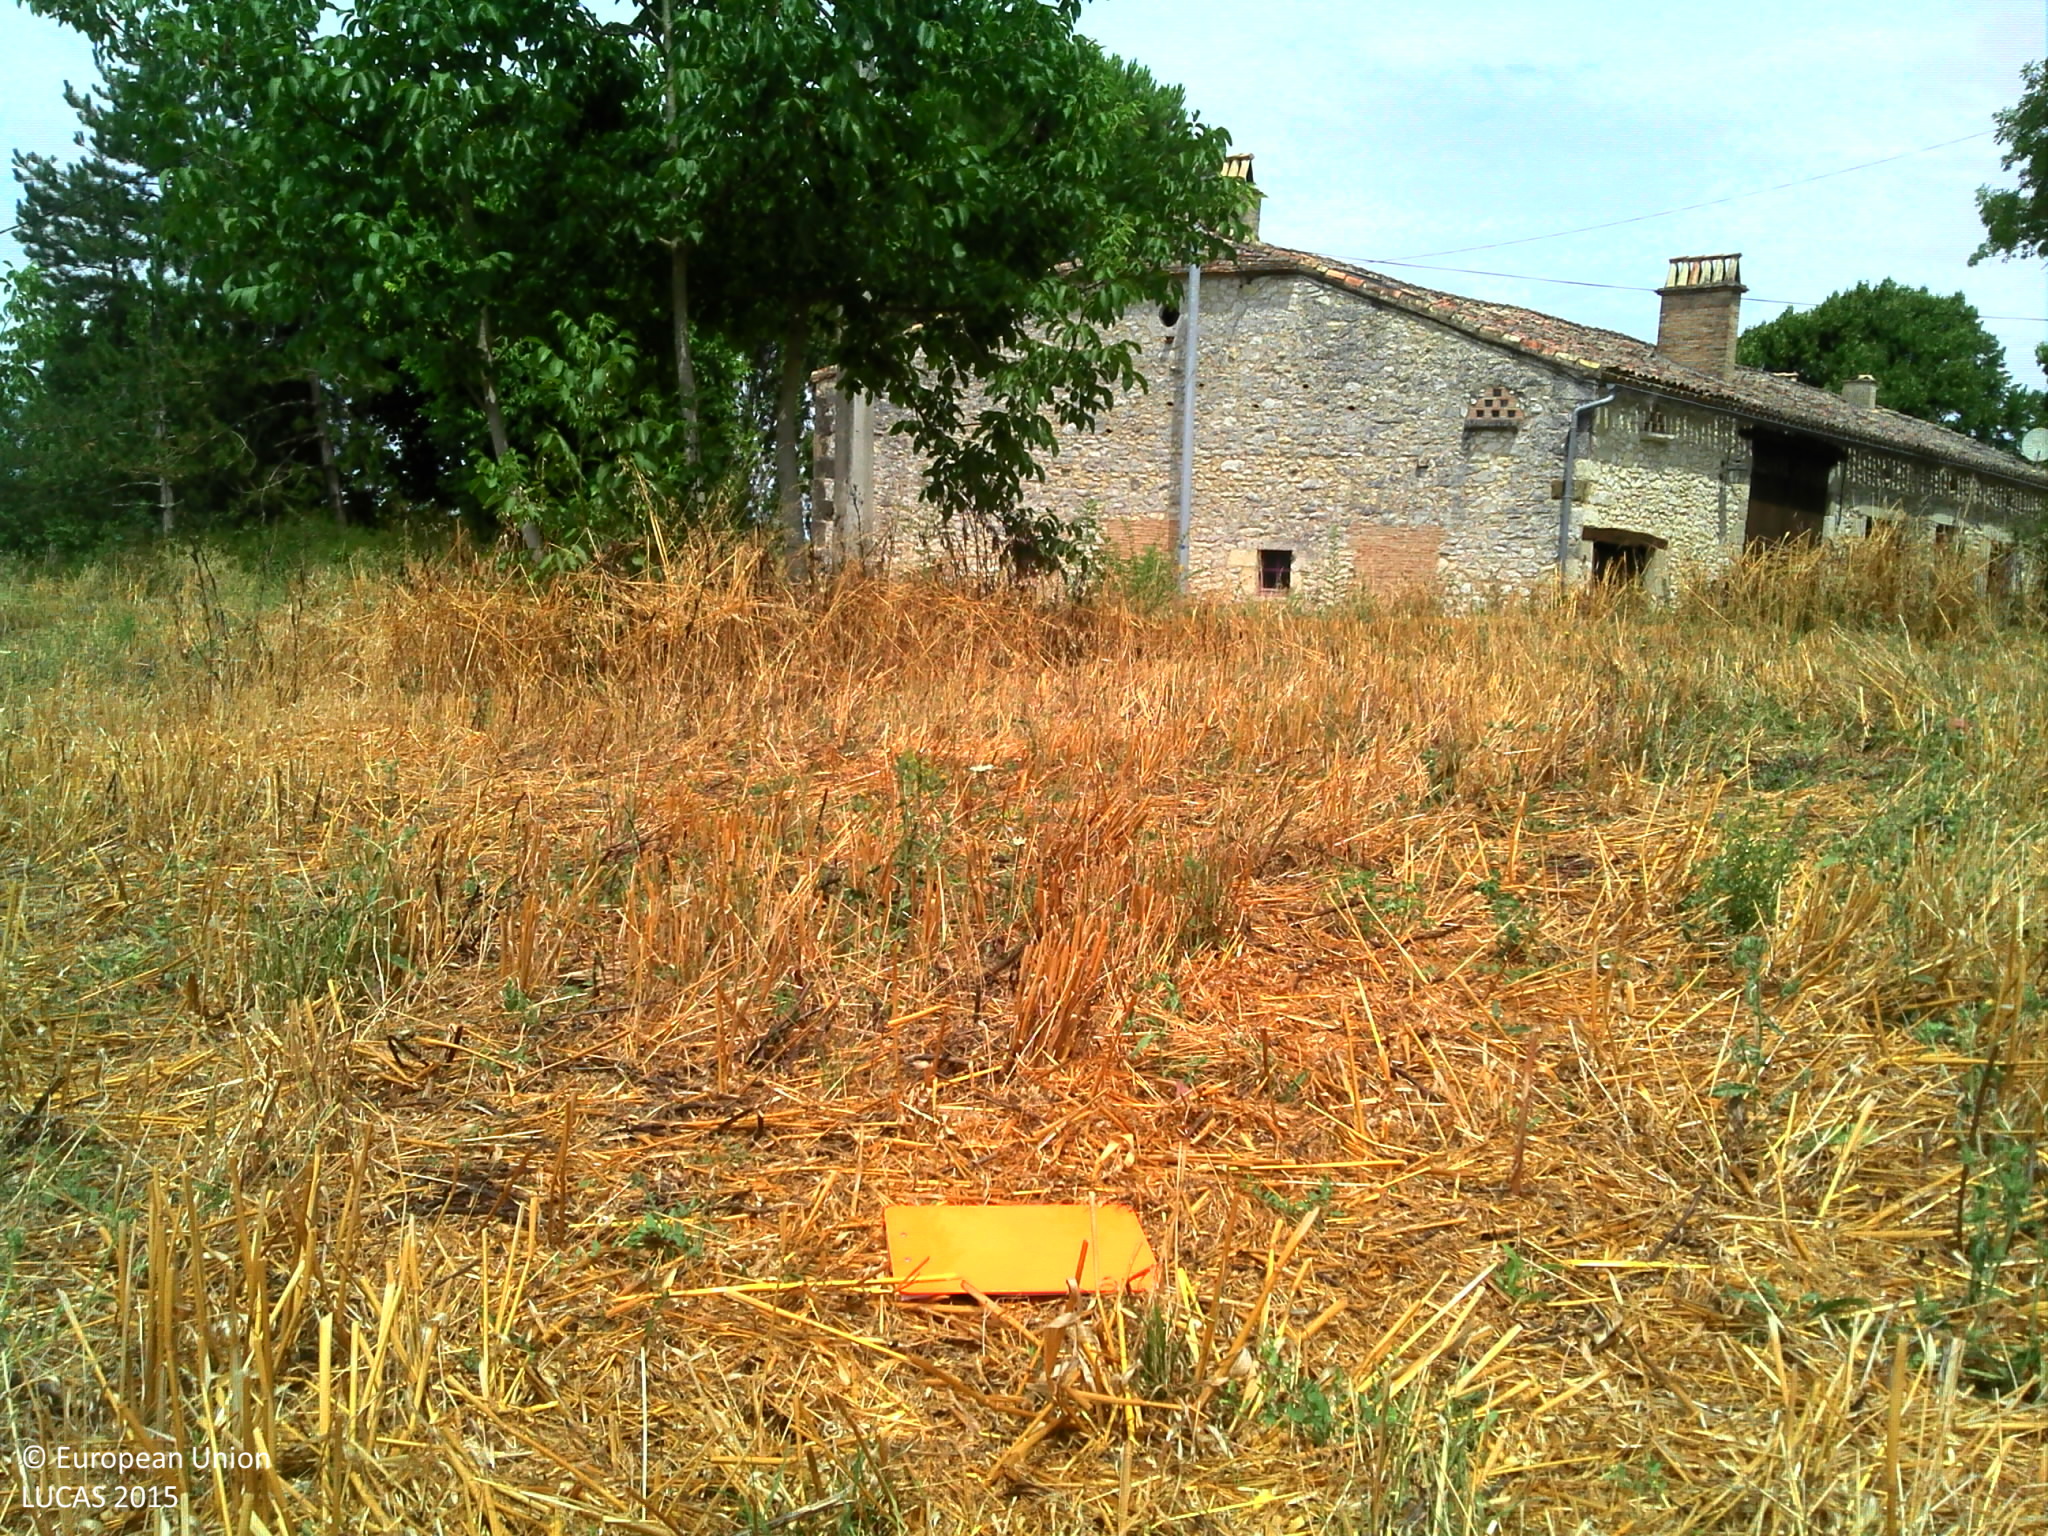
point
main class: Grassland
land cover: Grassland with sparse tree/shrub cover
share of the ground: > 75 %
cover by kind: herbaceous plants 95 %, broadleaved forest trees 5 %
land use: Agriculture (excluding fallow land and kitchen gardens)
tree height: < 5 m
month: July
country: FR
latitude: 44.6597
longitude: 0.5203
